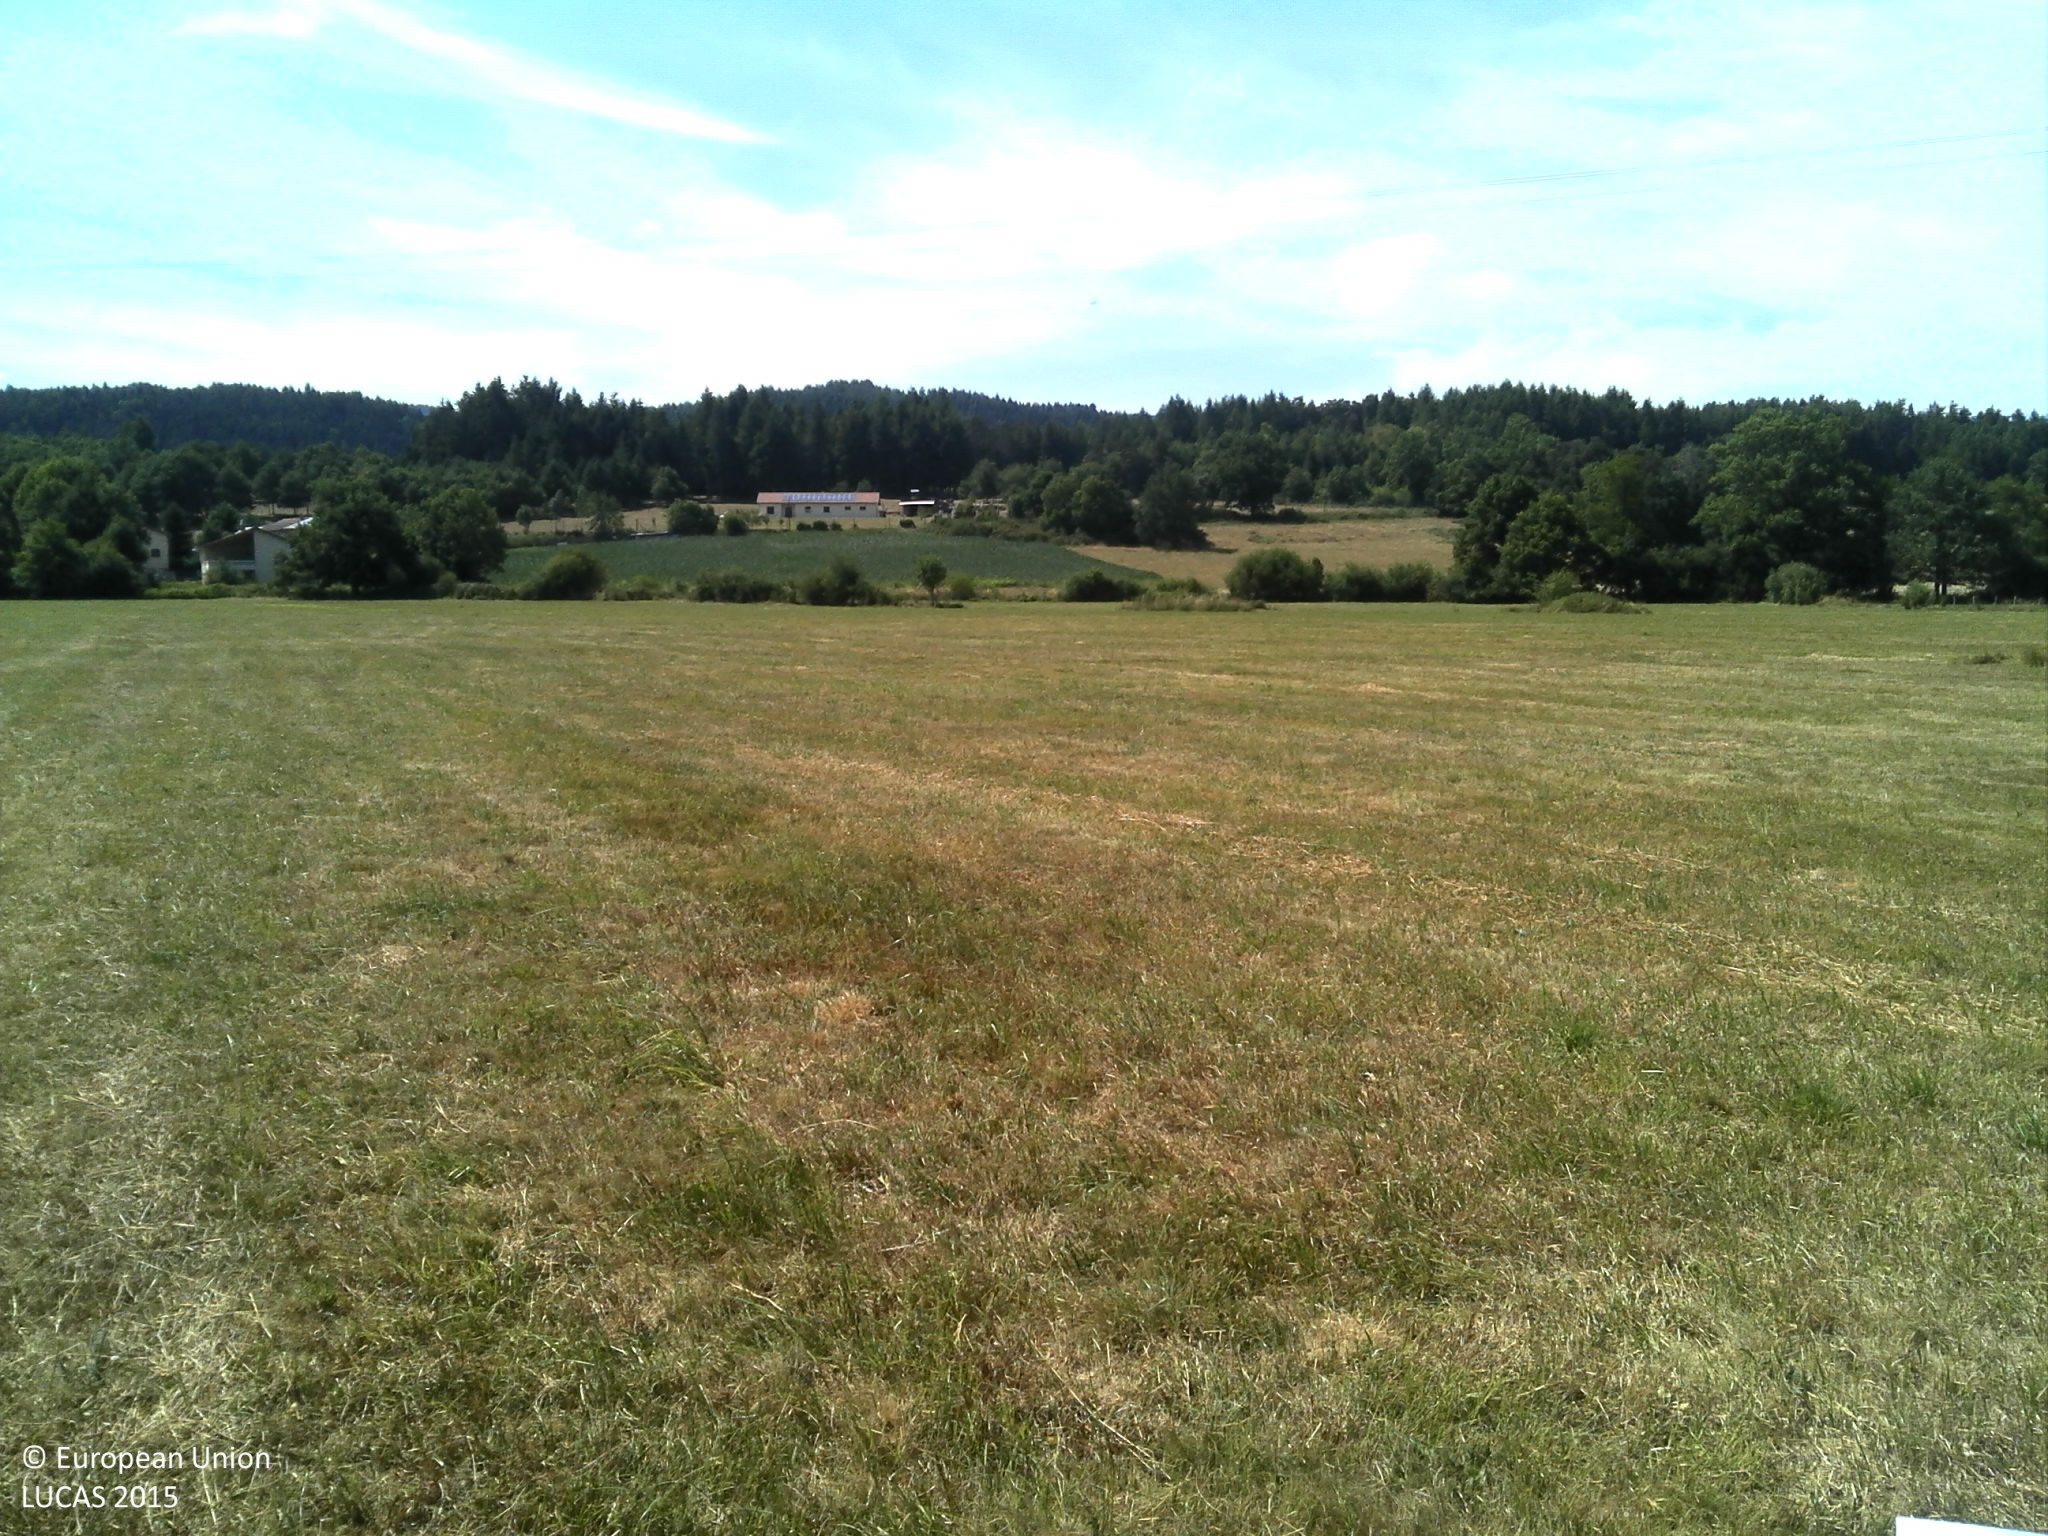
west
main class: Grassland
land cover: Grassland without tree/shrub cover
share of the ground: > 75 %
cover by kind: herbaceous plants 100 %
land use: Agriculture (excluding fallow land and kitchen gardens)
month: July
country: FR
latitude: 45.4622
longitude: 3.7230
